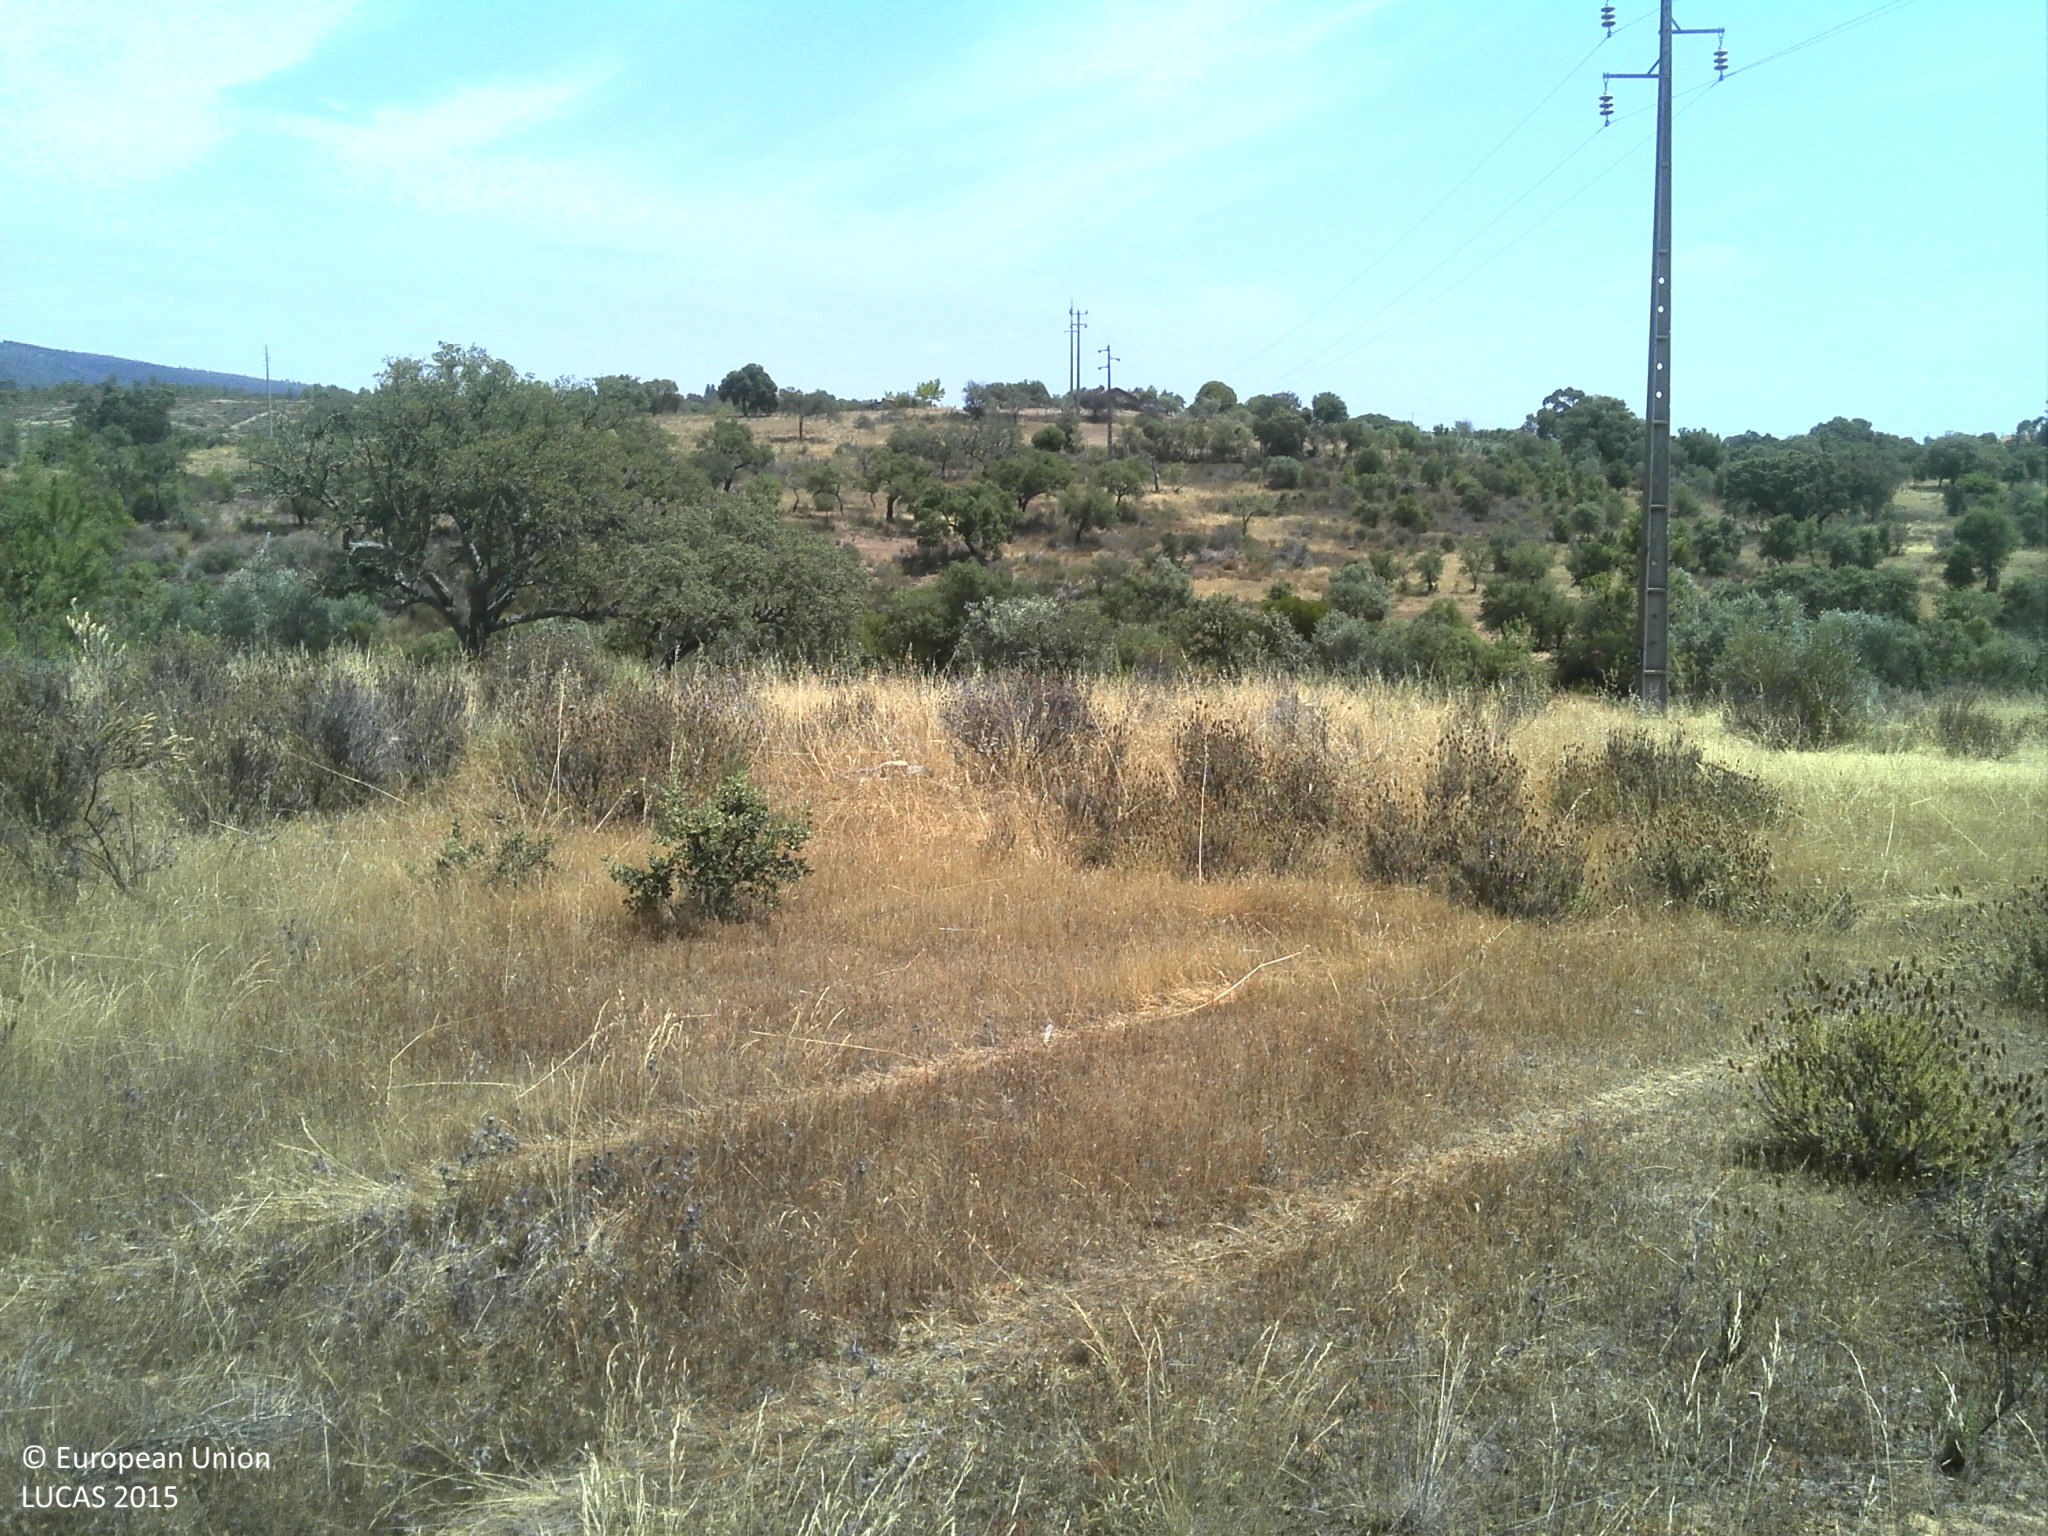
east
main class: Grassland
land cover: Grassland without tree/shrub cover
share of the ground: 25 - 50 %
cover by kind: unconsolidated bare surface 55 %, herbaceous plants 45 %
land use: Agriculture (excluding fallow land and kitchen gardens)
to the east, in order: Grassland without tree/shrub cover; Broadleaved woodland; Rivers and streams; Abandoned hedges; Olive groves; Broadleaved woodland; Inland fresh water bodies; Broadleaved woodland; Fences; Grassland without tree/shrub cover
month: June
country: PT
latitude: 39.9253
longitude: -7.0443
